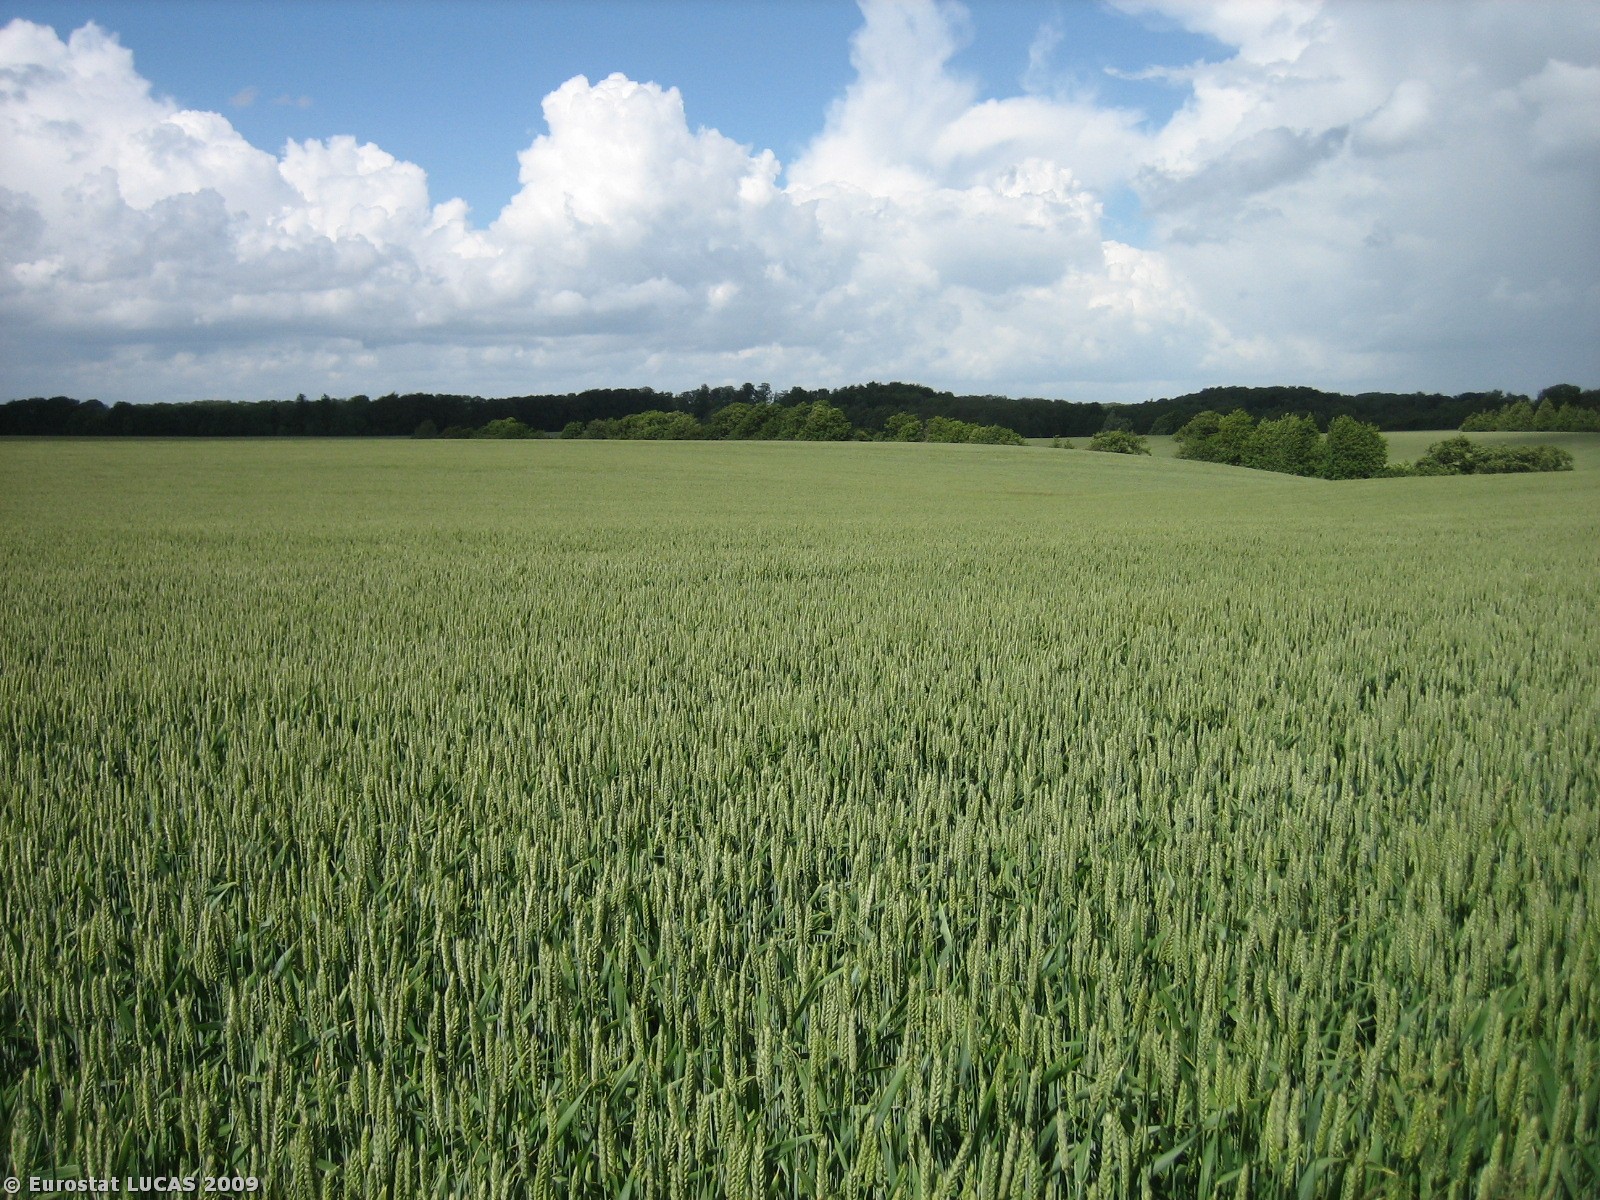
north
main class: Cropland
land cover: Common wheat
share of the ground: > 75 %
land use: Agriculture (excluding fallow land and kitchen gardens)
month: June
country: DK
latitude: 55.5942
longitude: 9.6988
